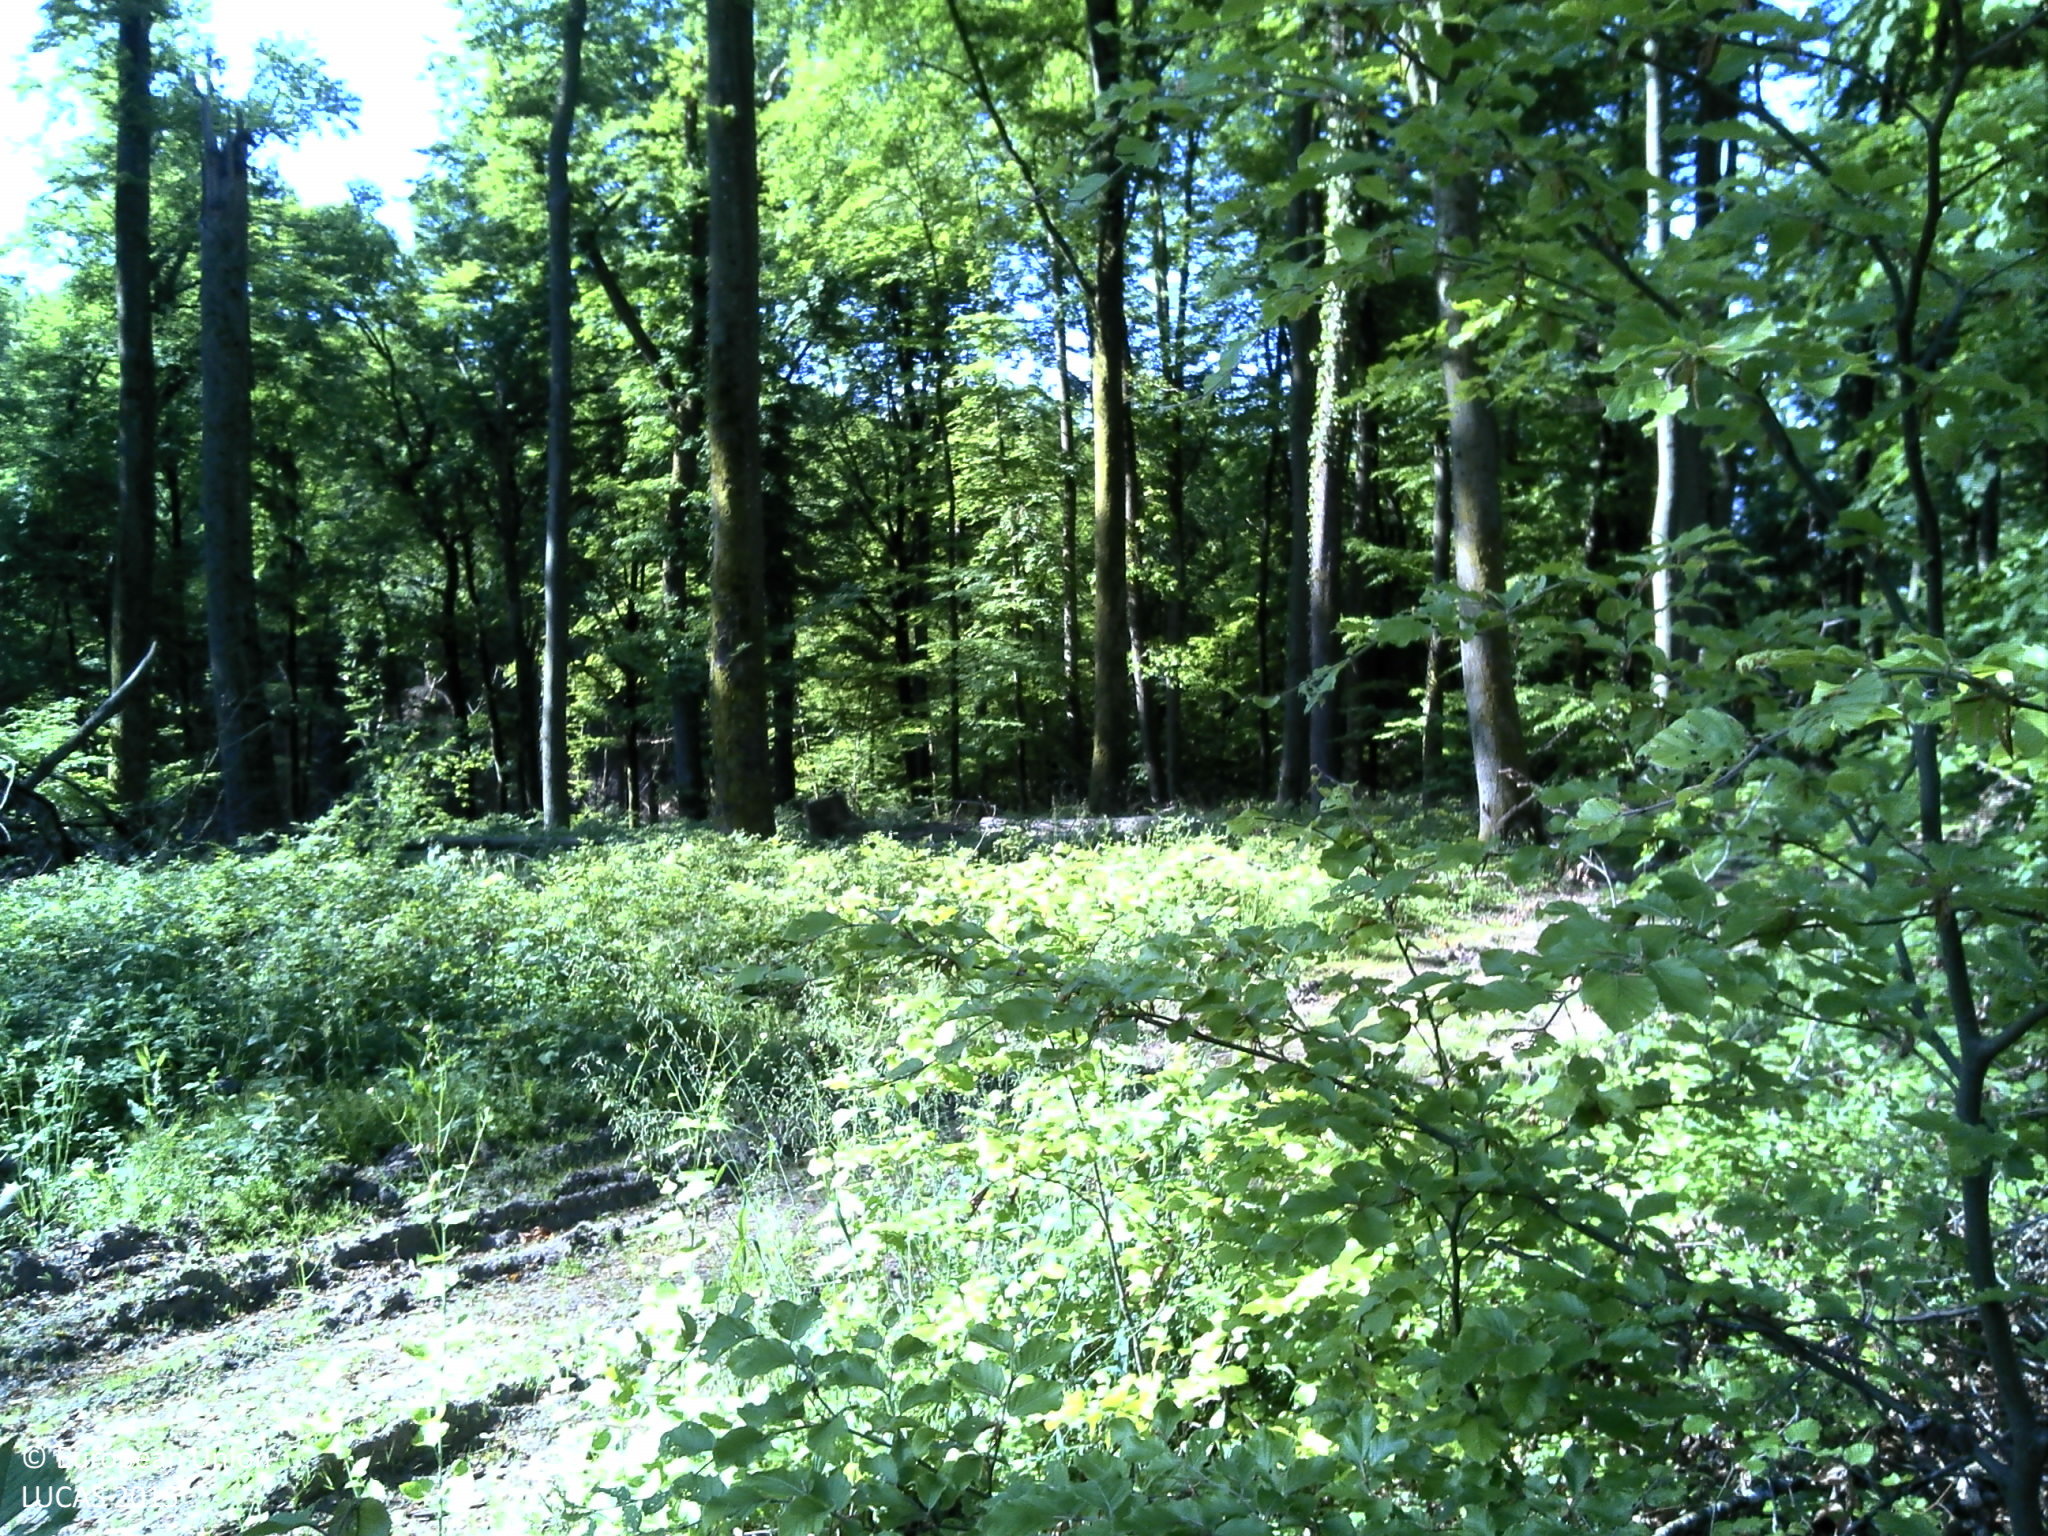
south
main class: Woodland
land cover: Broadleaved woodland
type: beech forest
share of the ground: > 75 %
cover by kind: broadleaved forest trees 100 %
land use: Forestry
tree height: > 5 m
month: May
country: LU
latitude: 49.6808
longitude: 5.9661
